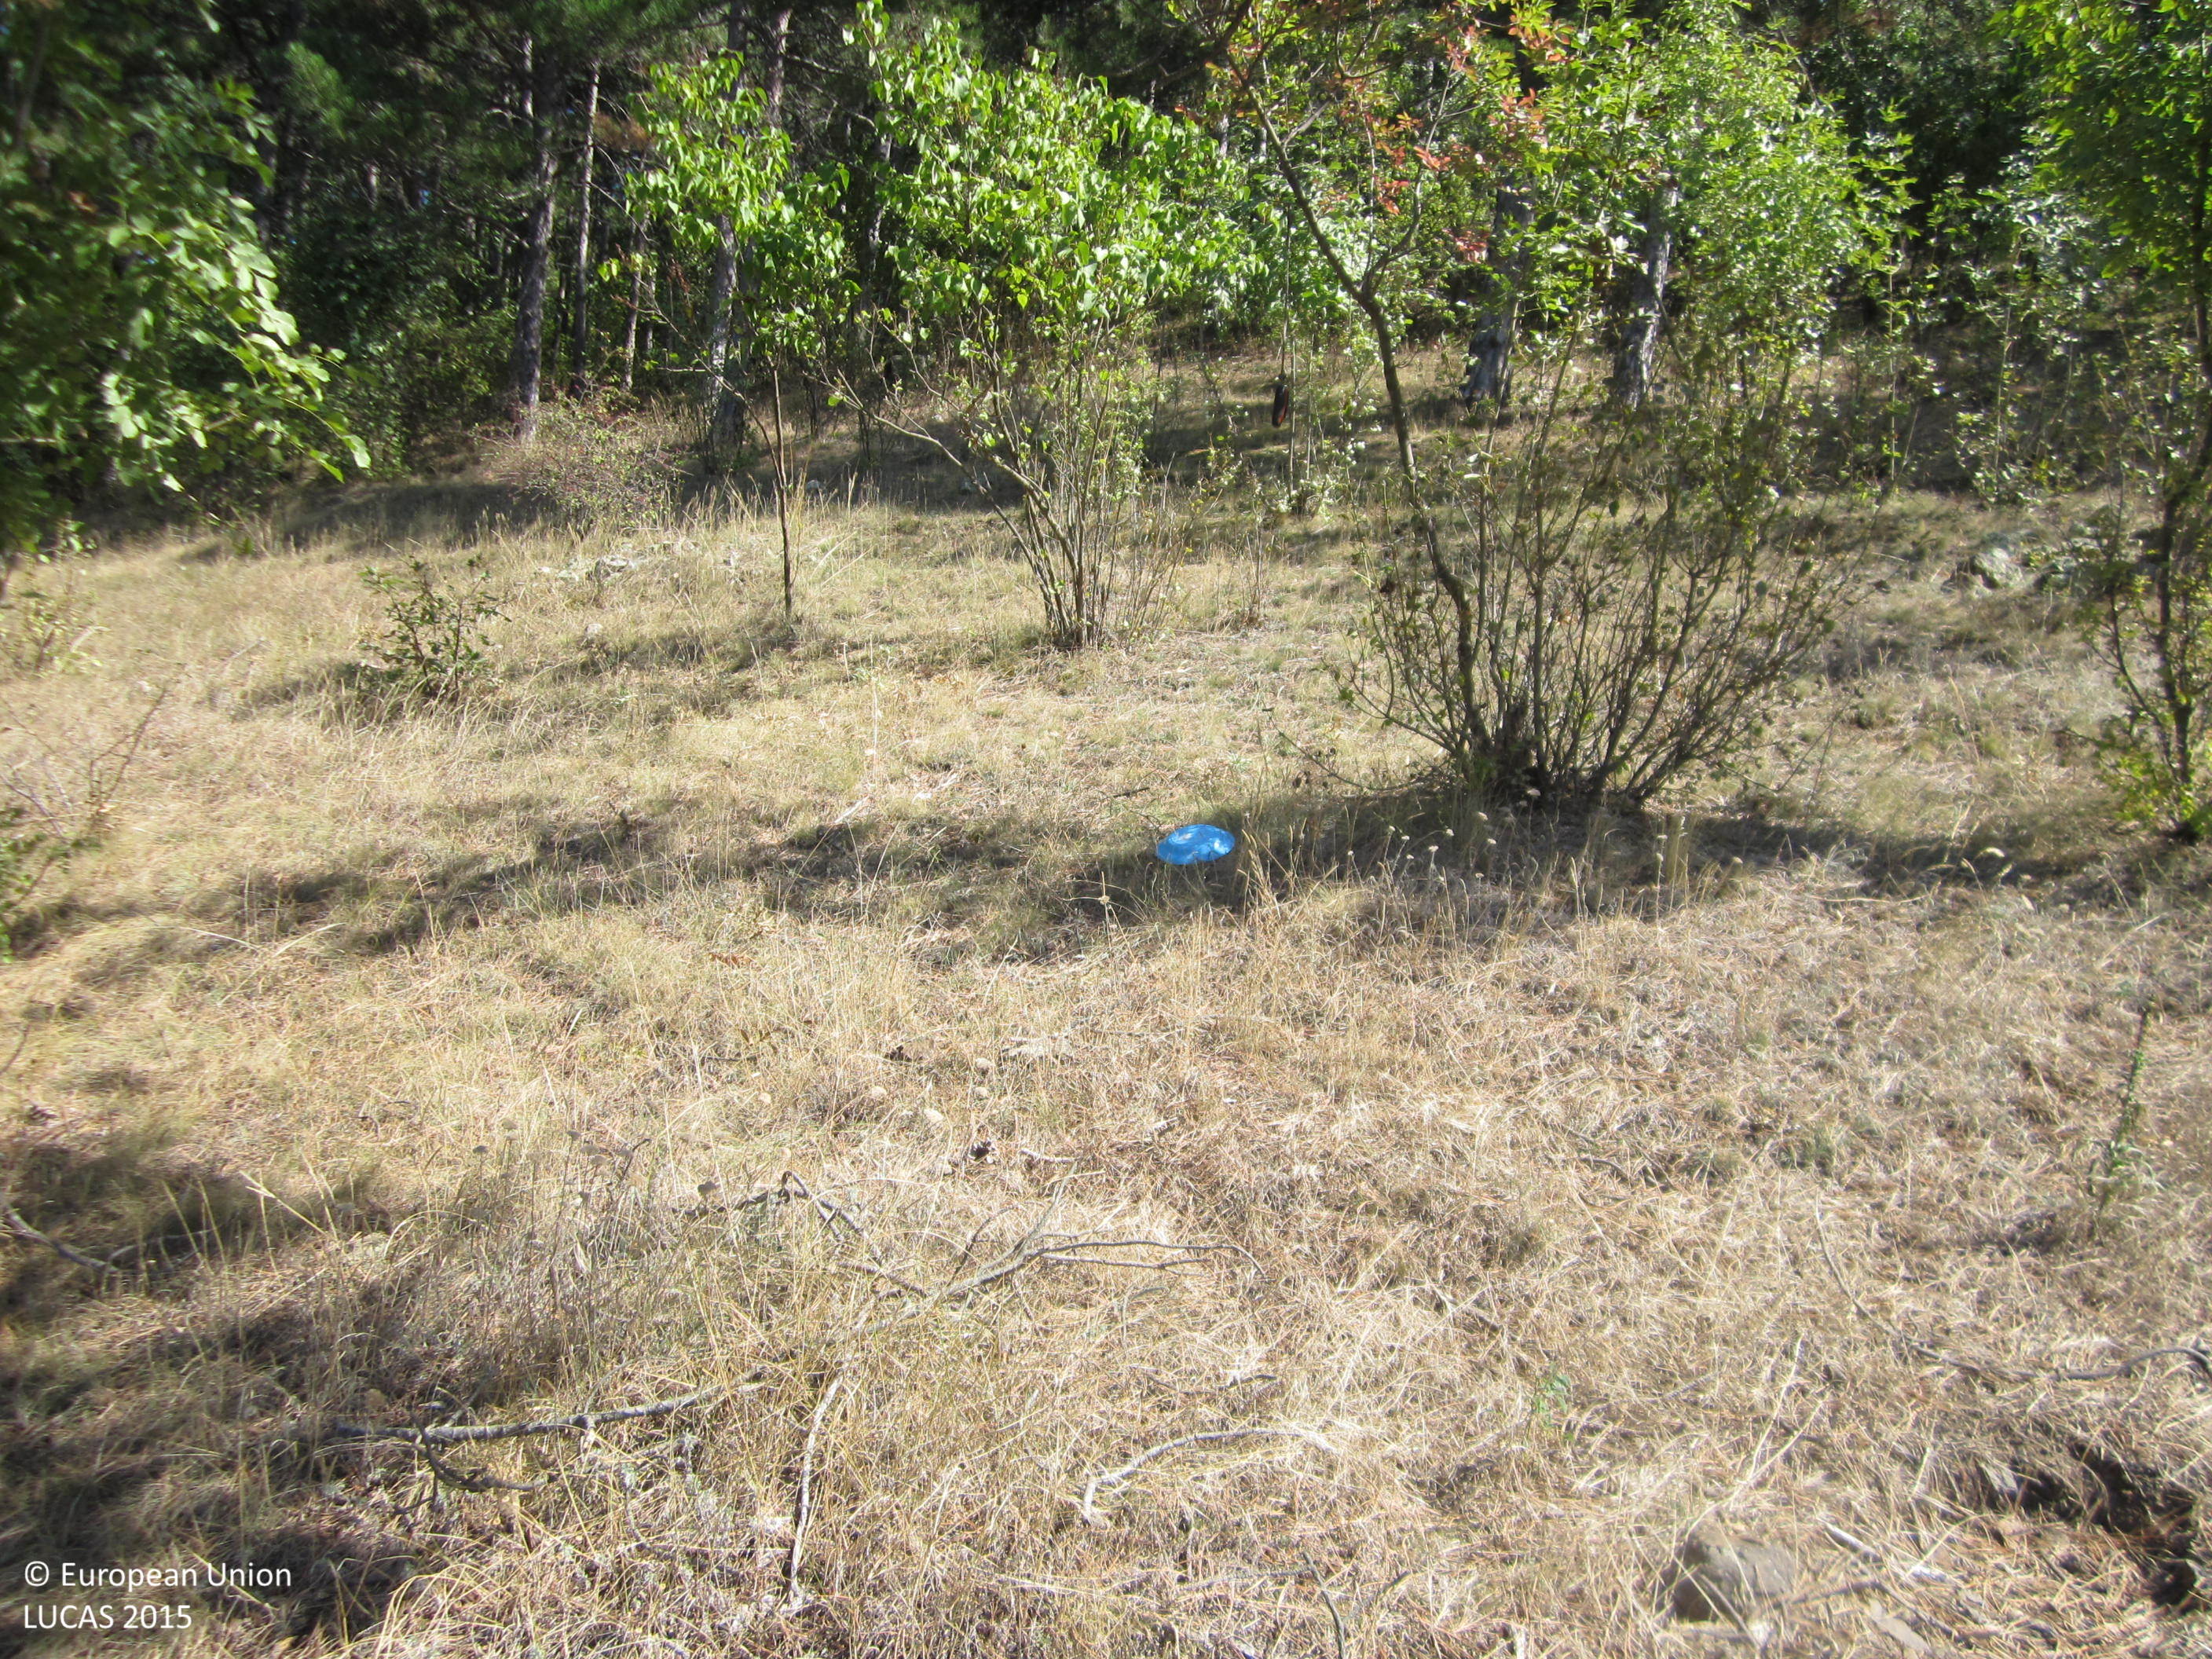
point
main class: Woodland
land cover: Pine dominated mixed woodland
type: hemiboreal forest and nemoral coniferous forest and mixed broadleaved-coniferous forest
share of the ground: > 75 %
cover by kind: coniferous forest trees 60 %, broadleaved forest trees 20 %, herbaceous plants 20 %
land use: Forestry
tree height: > 5 m
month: September
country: BG
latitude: 42.7054
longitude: 27.2674
